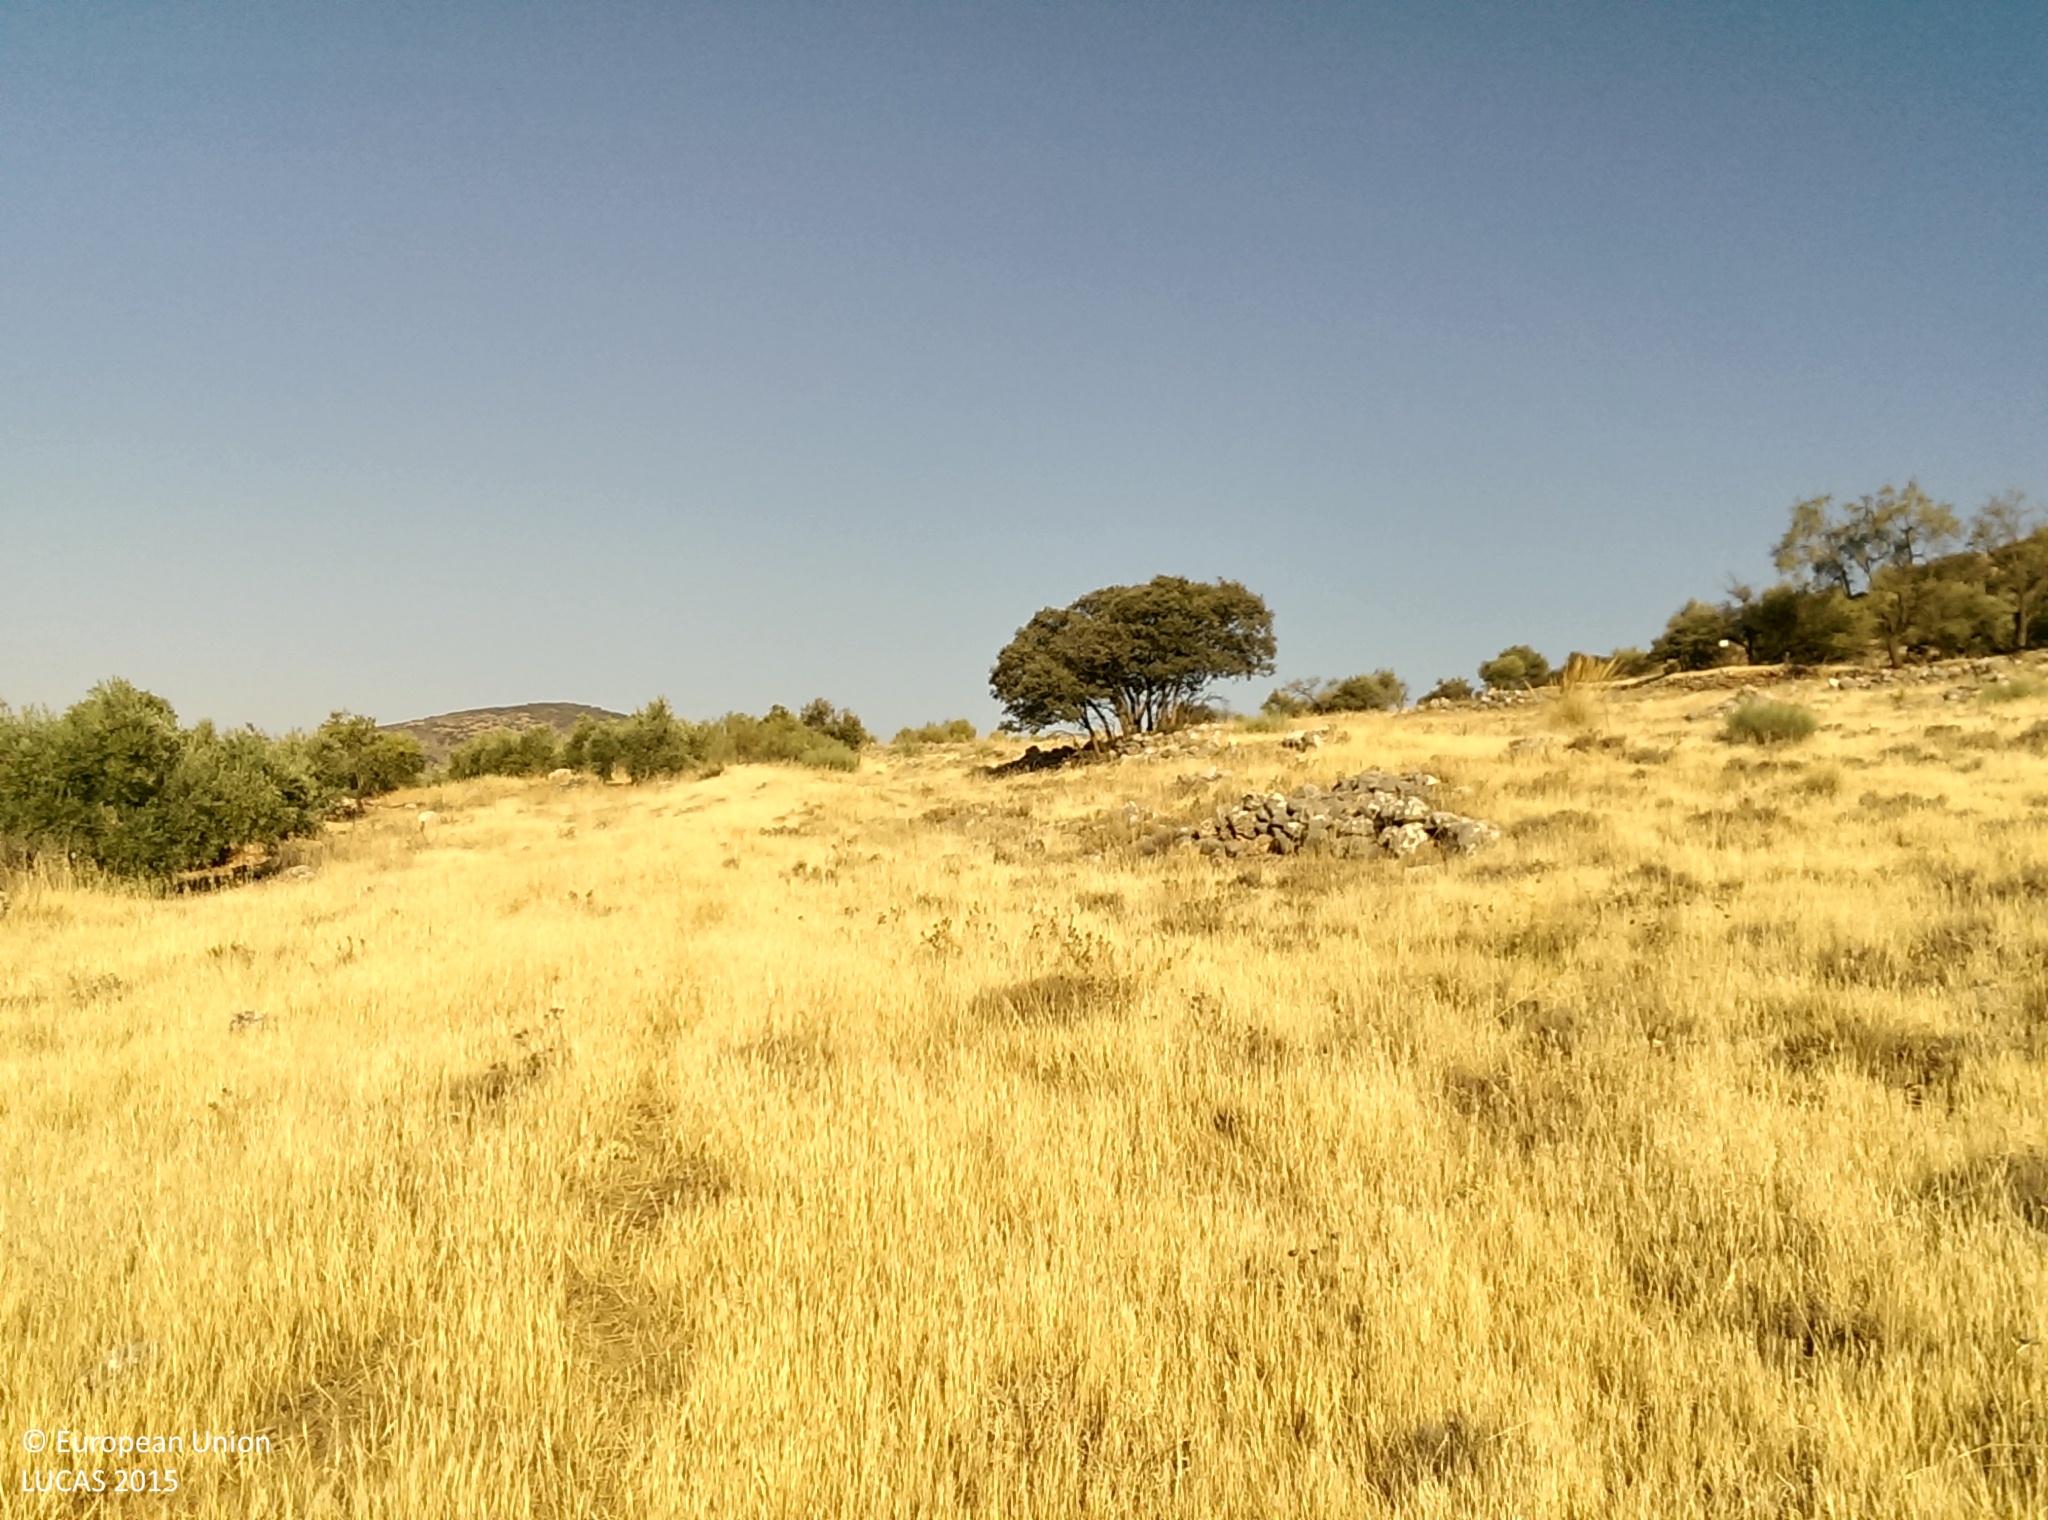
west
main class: Grassland
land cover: Grassland without tree/shrub cover
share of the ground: > 75 %
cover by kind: herbaceous plants 100 %
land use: Agriculture (excluding fallow land and kitchen gardens)
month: July
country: ES
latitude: 37.3765
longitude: -3.6917
